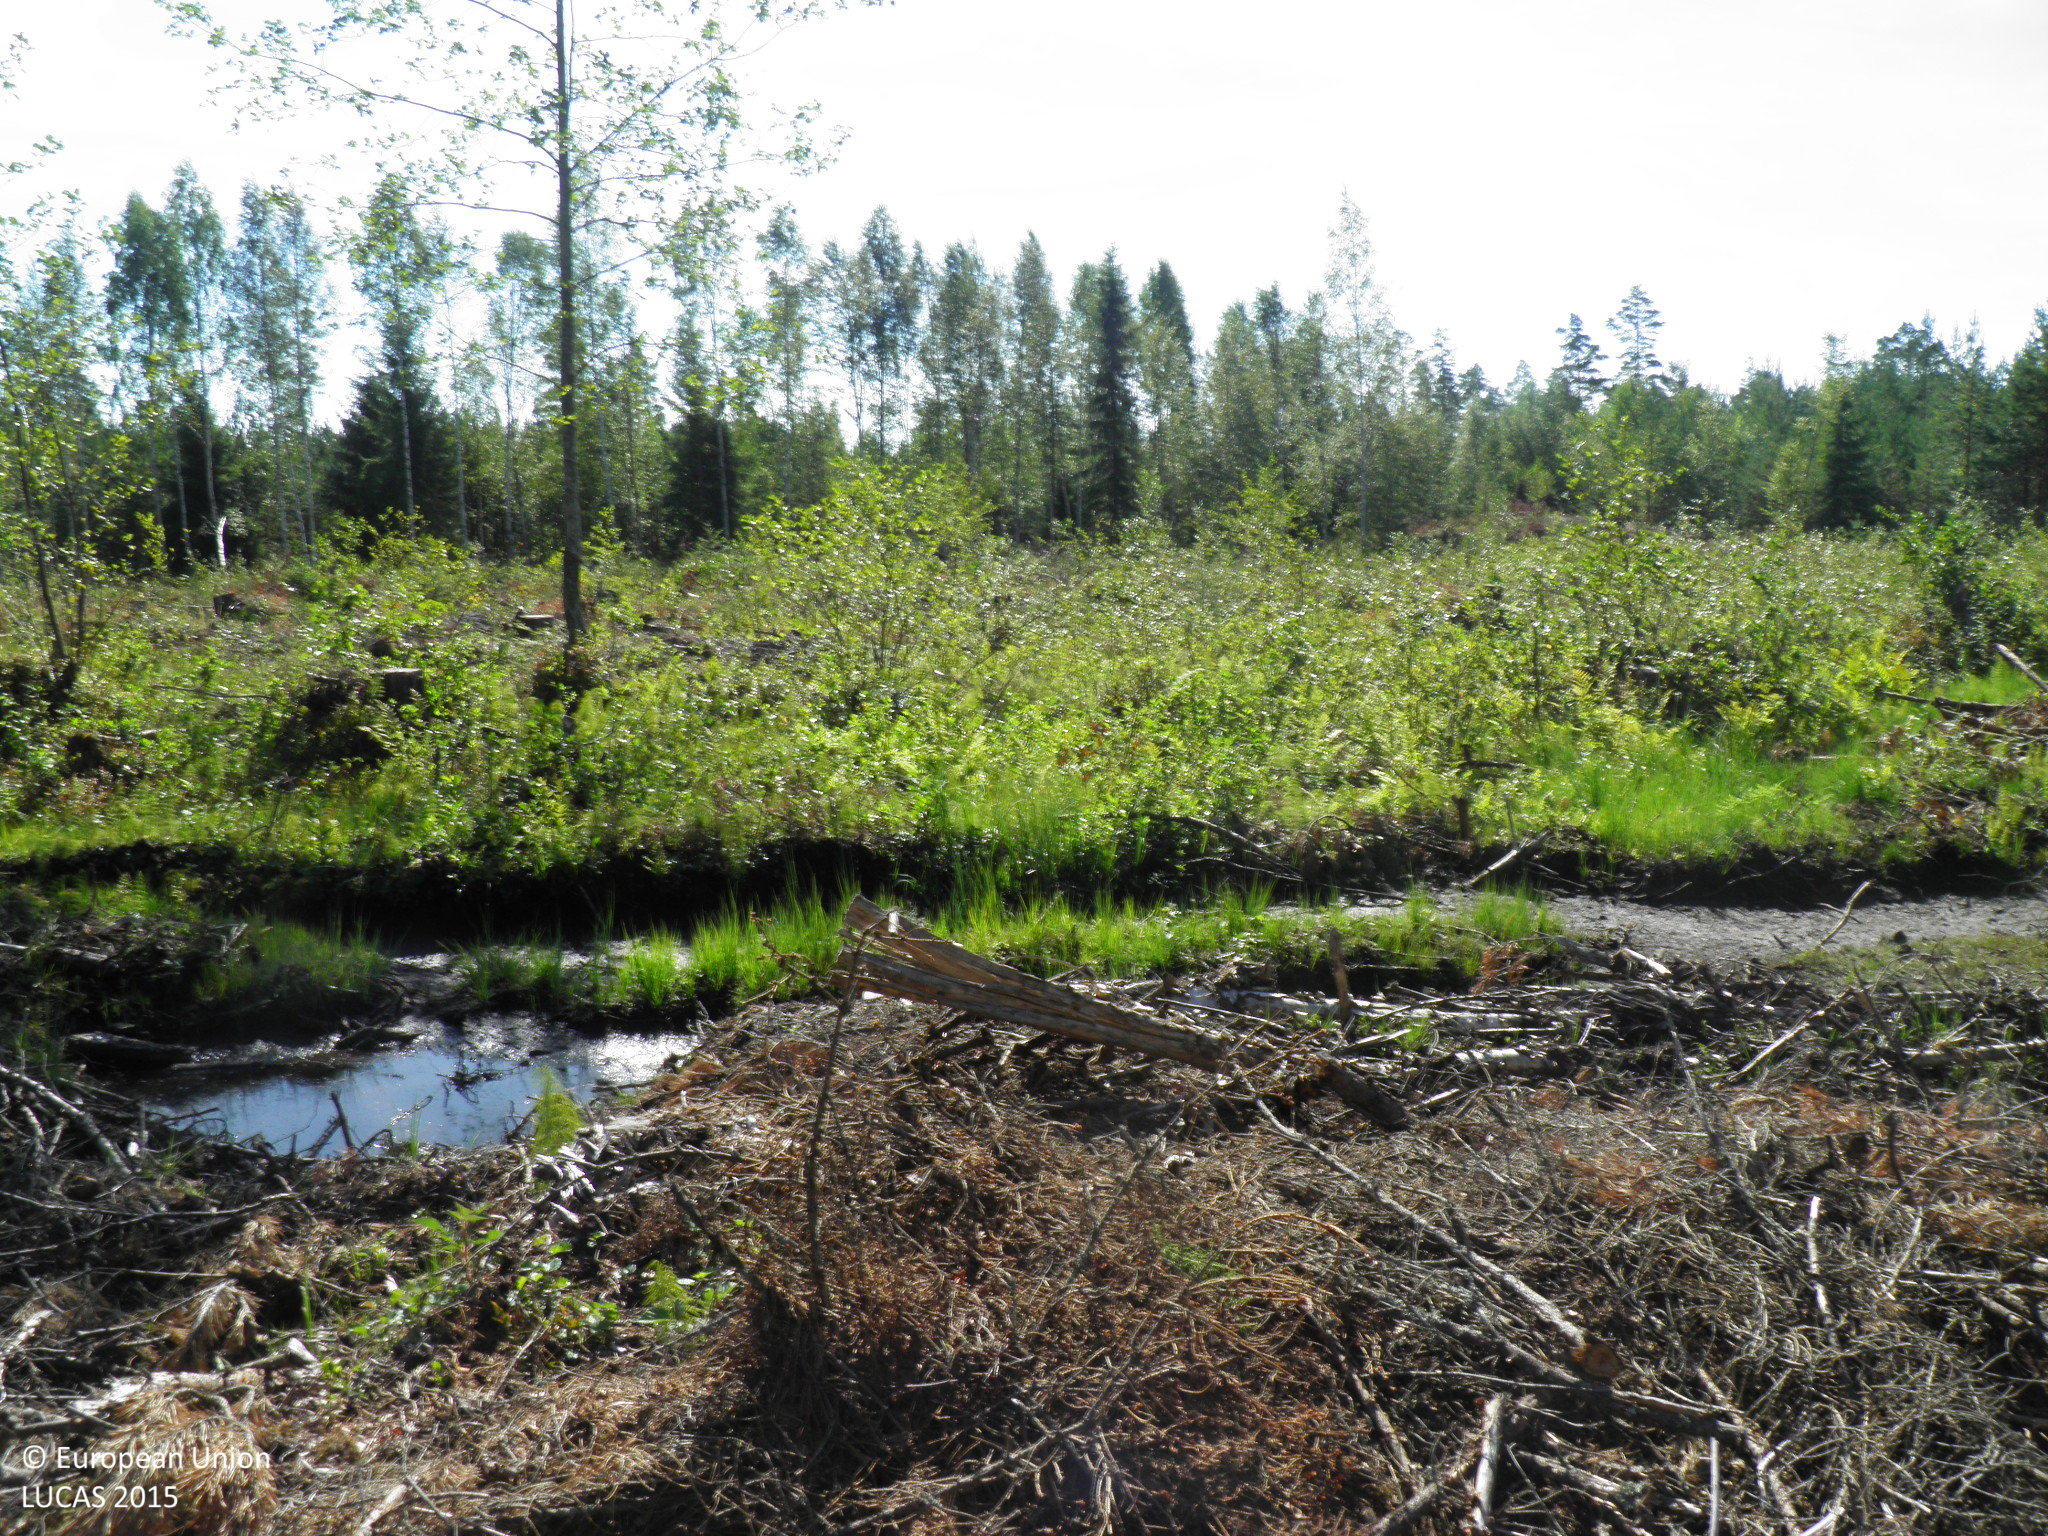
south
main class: Grassland
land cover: Spontaneously vegetated surfaces
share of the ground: 10 - 25 %
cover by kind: unconsolidated bare surface 50 %, consolidated bare surface 15 %, herbaceous plants 10 %, shrubs 5 %
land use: Forestry
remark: Clear cut
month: August
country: FI
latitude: 60.0568
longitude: 22.7392
